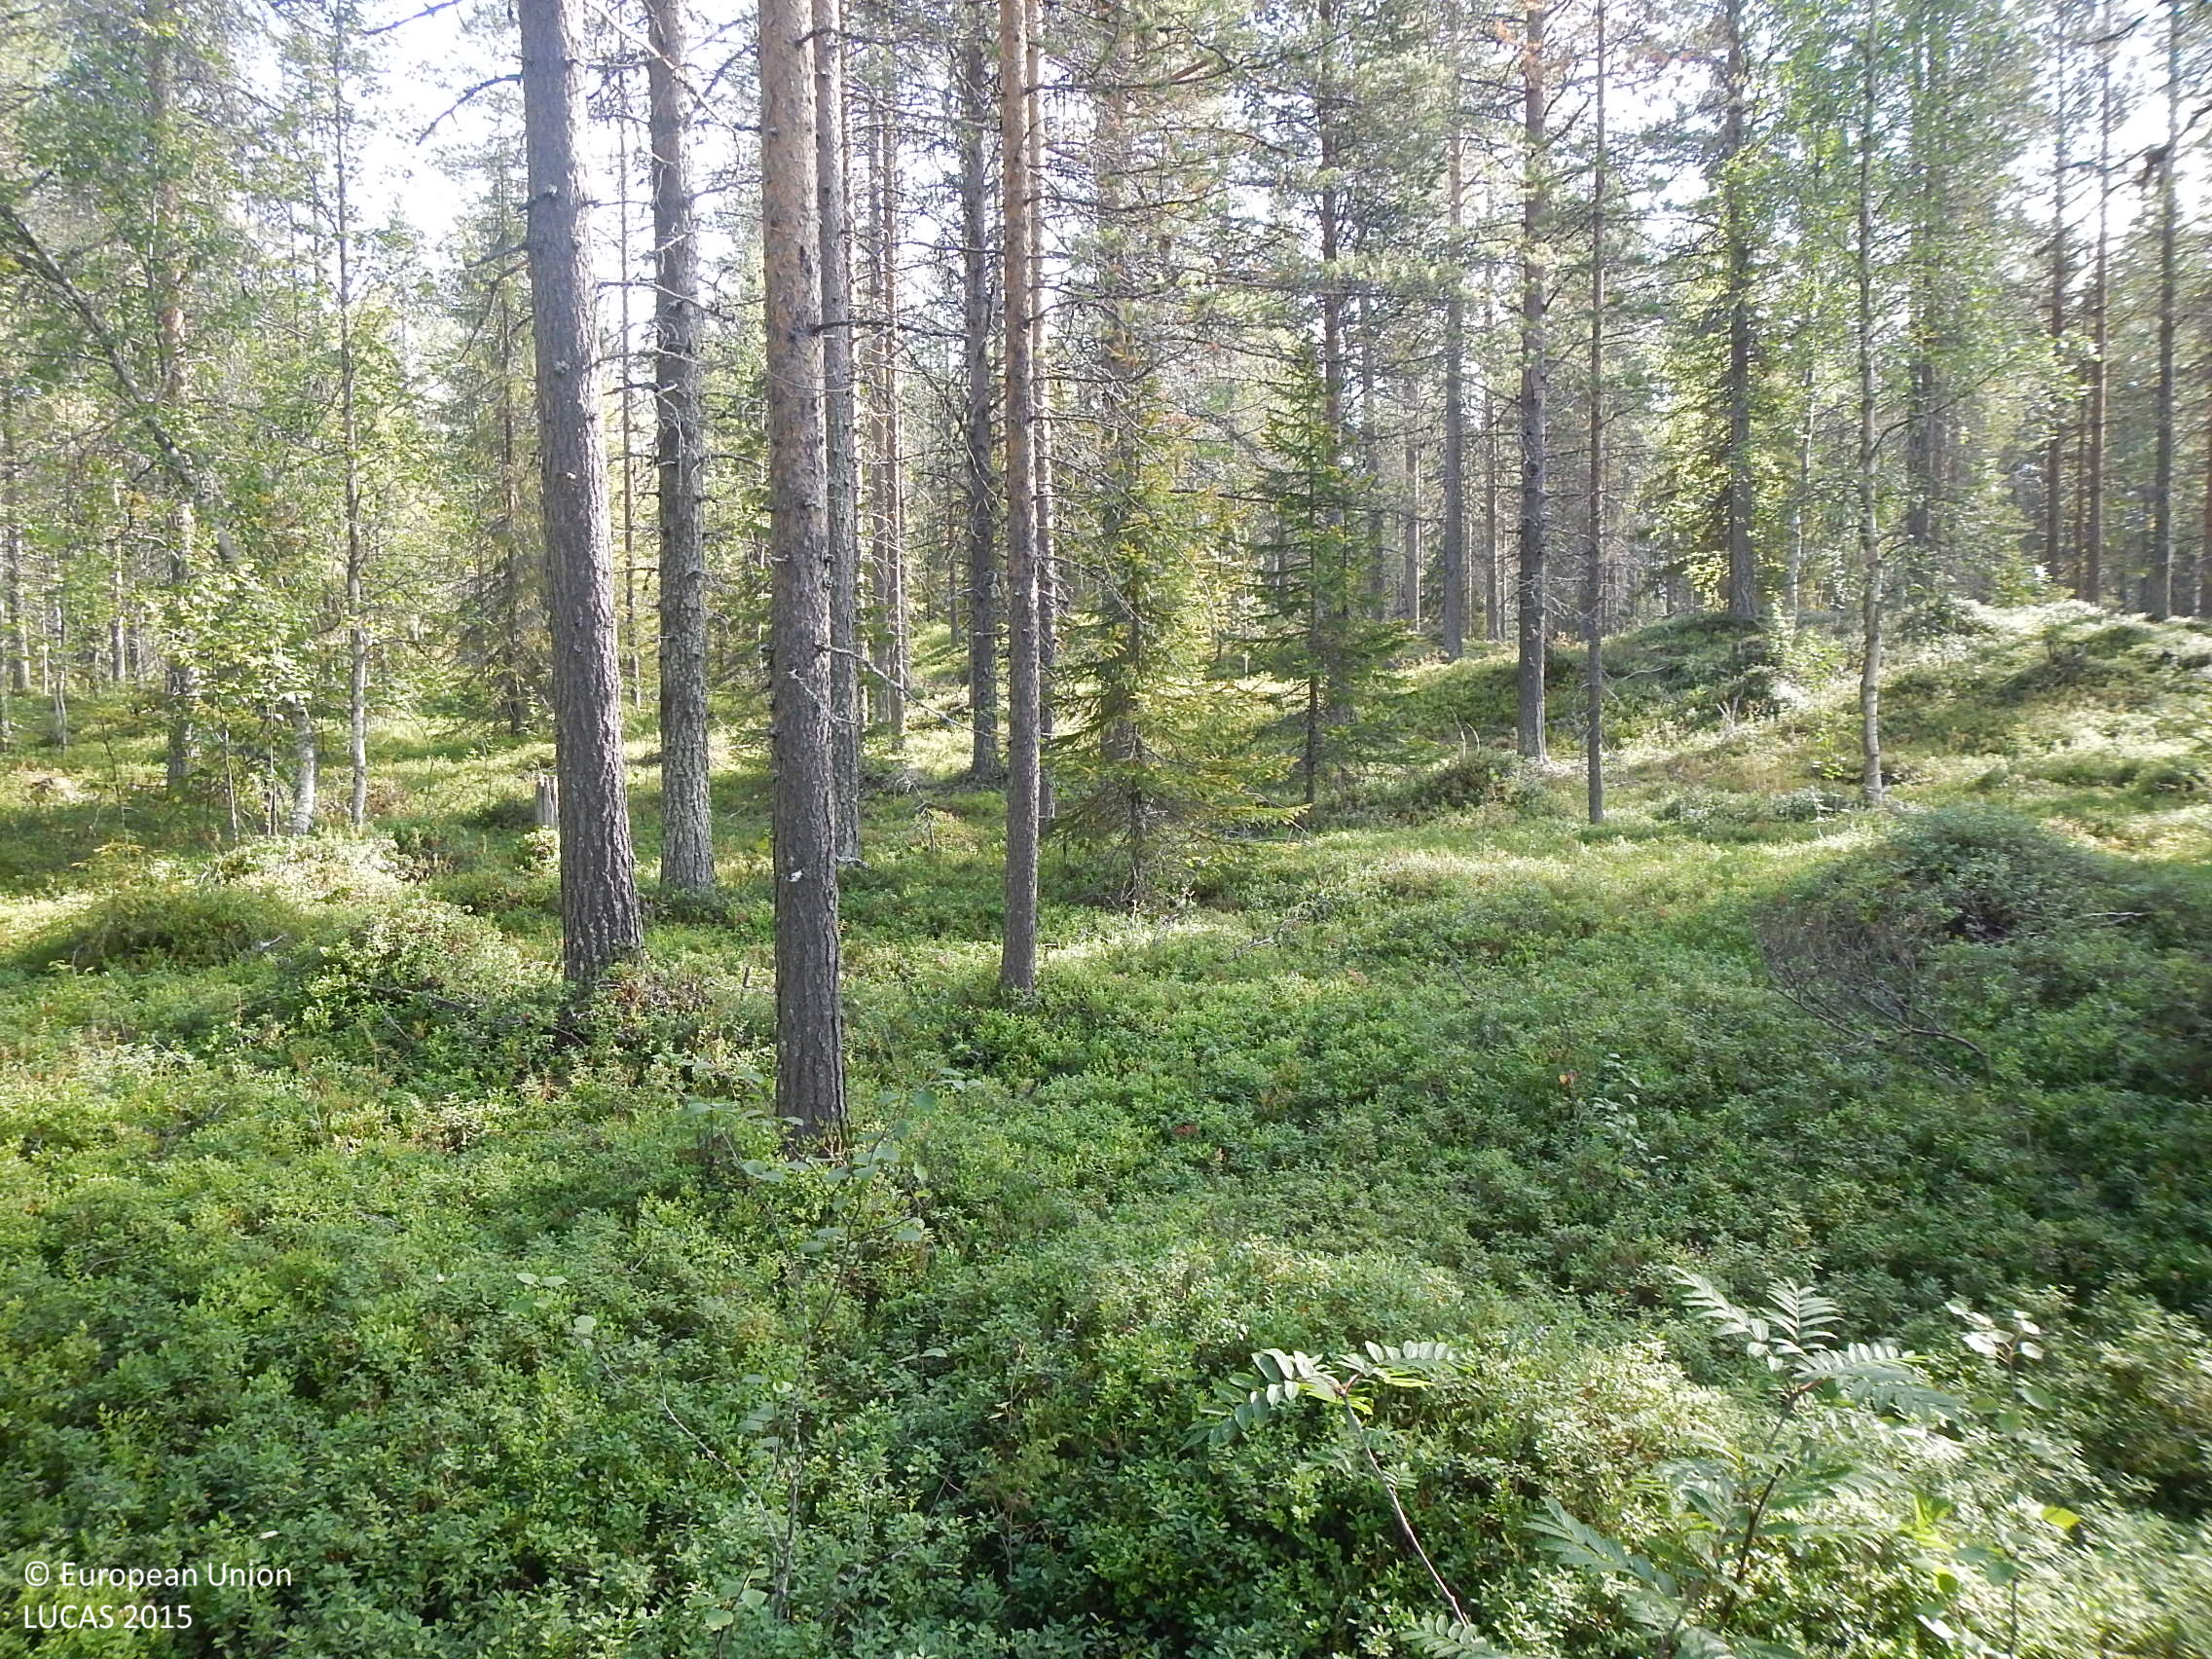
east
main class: Woodland
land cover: Pine dominated mixed woodland
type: boreal forest
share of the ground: 50 - 75 %
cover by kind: coniferous forest trees 35 %, shrubs 35 %, broadleaved forest trees 30 %
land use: Forestry
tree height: > 5 m
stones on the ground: 10 - 25 %
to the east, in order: Pine dominated mixed woodland; Other mixed woodland; Tracks; Other mixed woodland; Electric lines; Pine dominated mixed woodland; Other mixed woodland
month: August
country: FI
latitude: 67.1753
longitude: 26.2174
